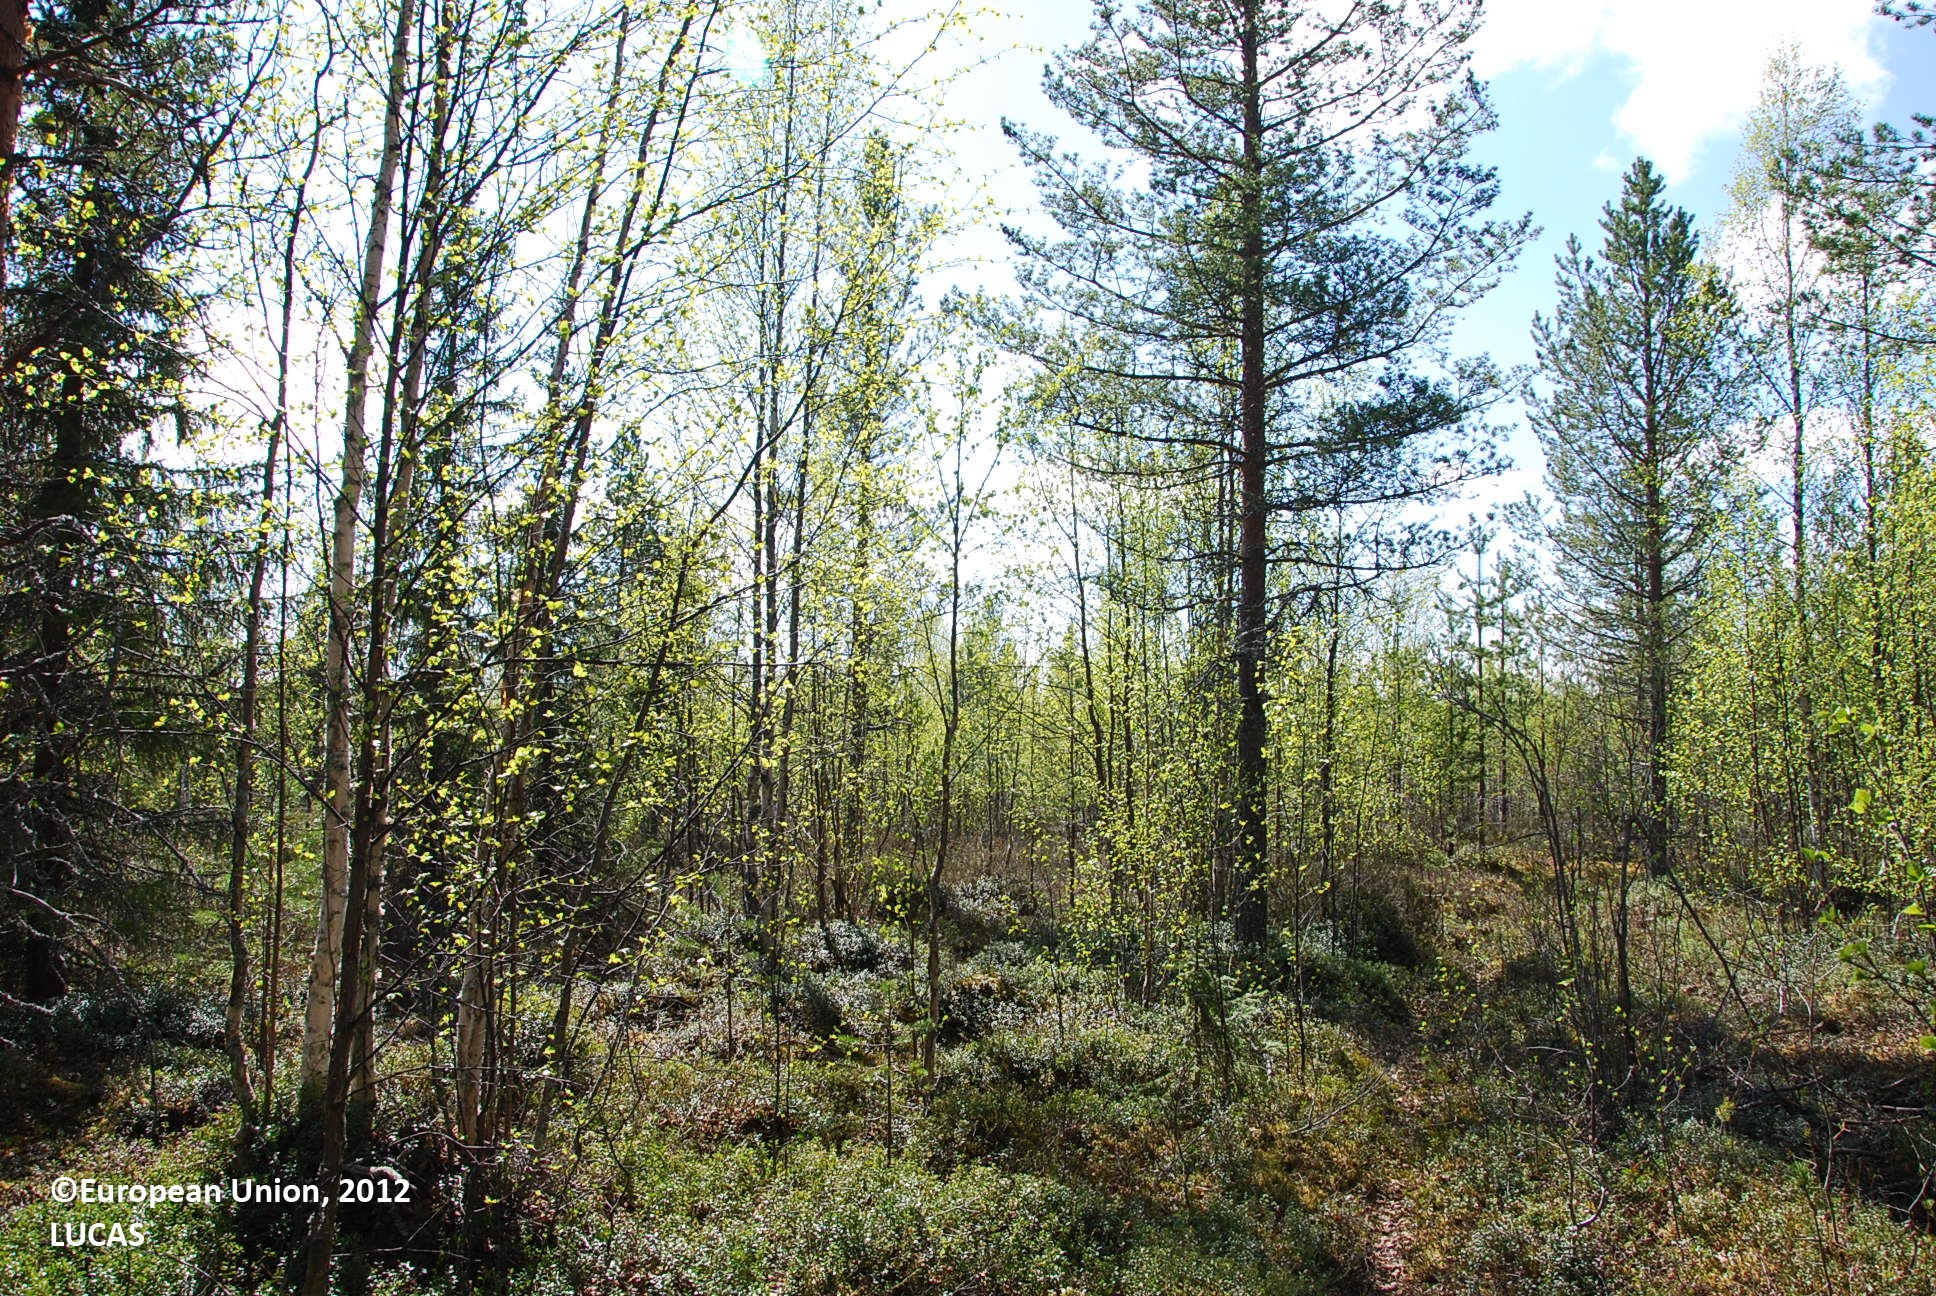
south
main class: Woodland
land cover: Pine dominated mixed woodland
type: boreal forest
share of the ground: 50 - 75 %
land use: Forestry
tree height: > 5 m
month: June
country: FI
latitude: 66.9890
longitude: 28.0734
